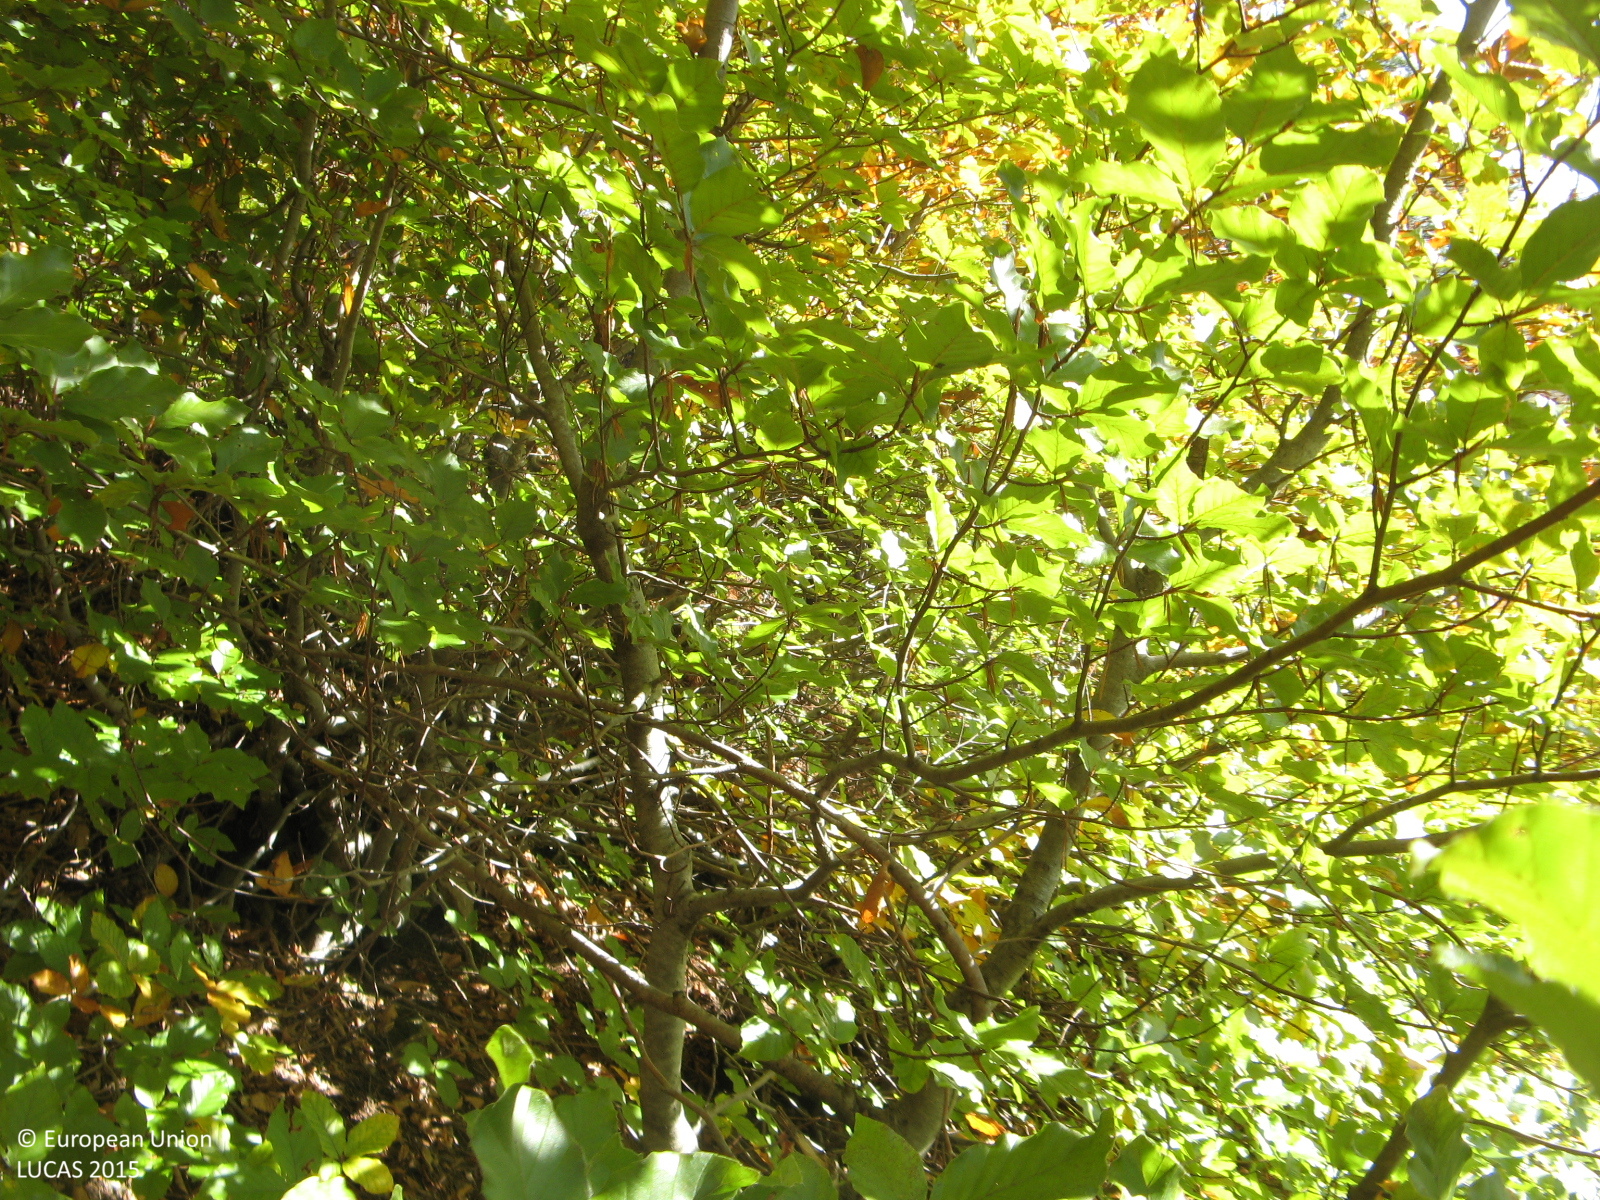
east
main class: Woodland
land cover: Pine dominated mixed woodland
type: hemiboreal forest and nemoral coniferous forest and mixed broadleaved-coniferous forest
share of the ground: > 75 %
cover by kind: coniferous forest trees 50 %, broadleaved forest trees 50 %
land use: Forestry
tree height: > 5 m
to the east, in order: Pine dominated mixed woodland; Tracks; Pine dominated mixed woodland; Grassland with sparse tree/shrub cover; Abandoned hedges; Grassland without tree/shrub cover; Other bare soil; Electric lines; Other bare soil; Grassland without tree/shrub cover; Ditches and canals; Paved roads, cycling and walking lanes; Lines of trees; Grass margins; Single bushes/trees; Spontaneously vegetated surfaces; Grassland without tree/shrub cover; Broadleaved woodland; Inland fresh running water; Rocks and stones; Pine dominated mixed woodland
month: October
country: BG
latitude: 41.4812
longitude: 24.8353
